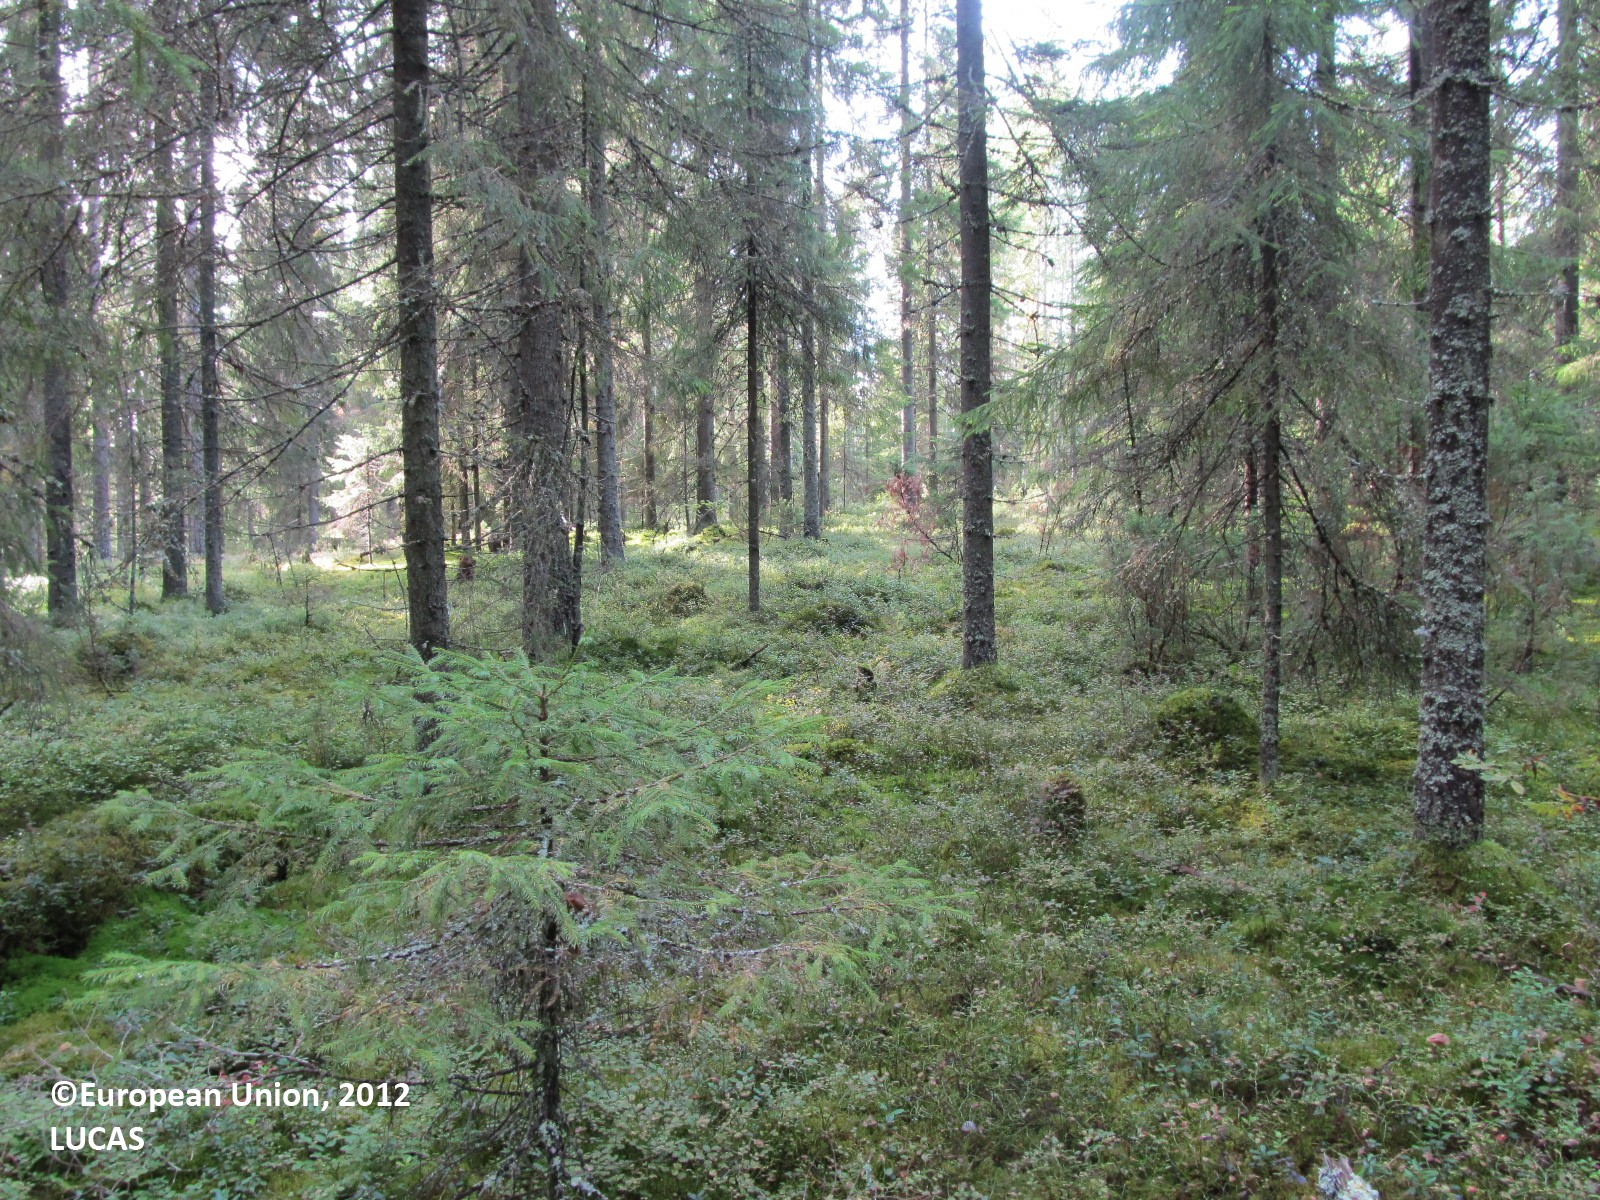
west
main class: Woodland
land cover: Spruce dominated coniferous woodland
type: boreal forest
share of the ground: 50 - 75 %
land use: Forestry
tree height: > 5 m
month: September
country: FI
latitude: 62.9097
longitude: 28.4404
